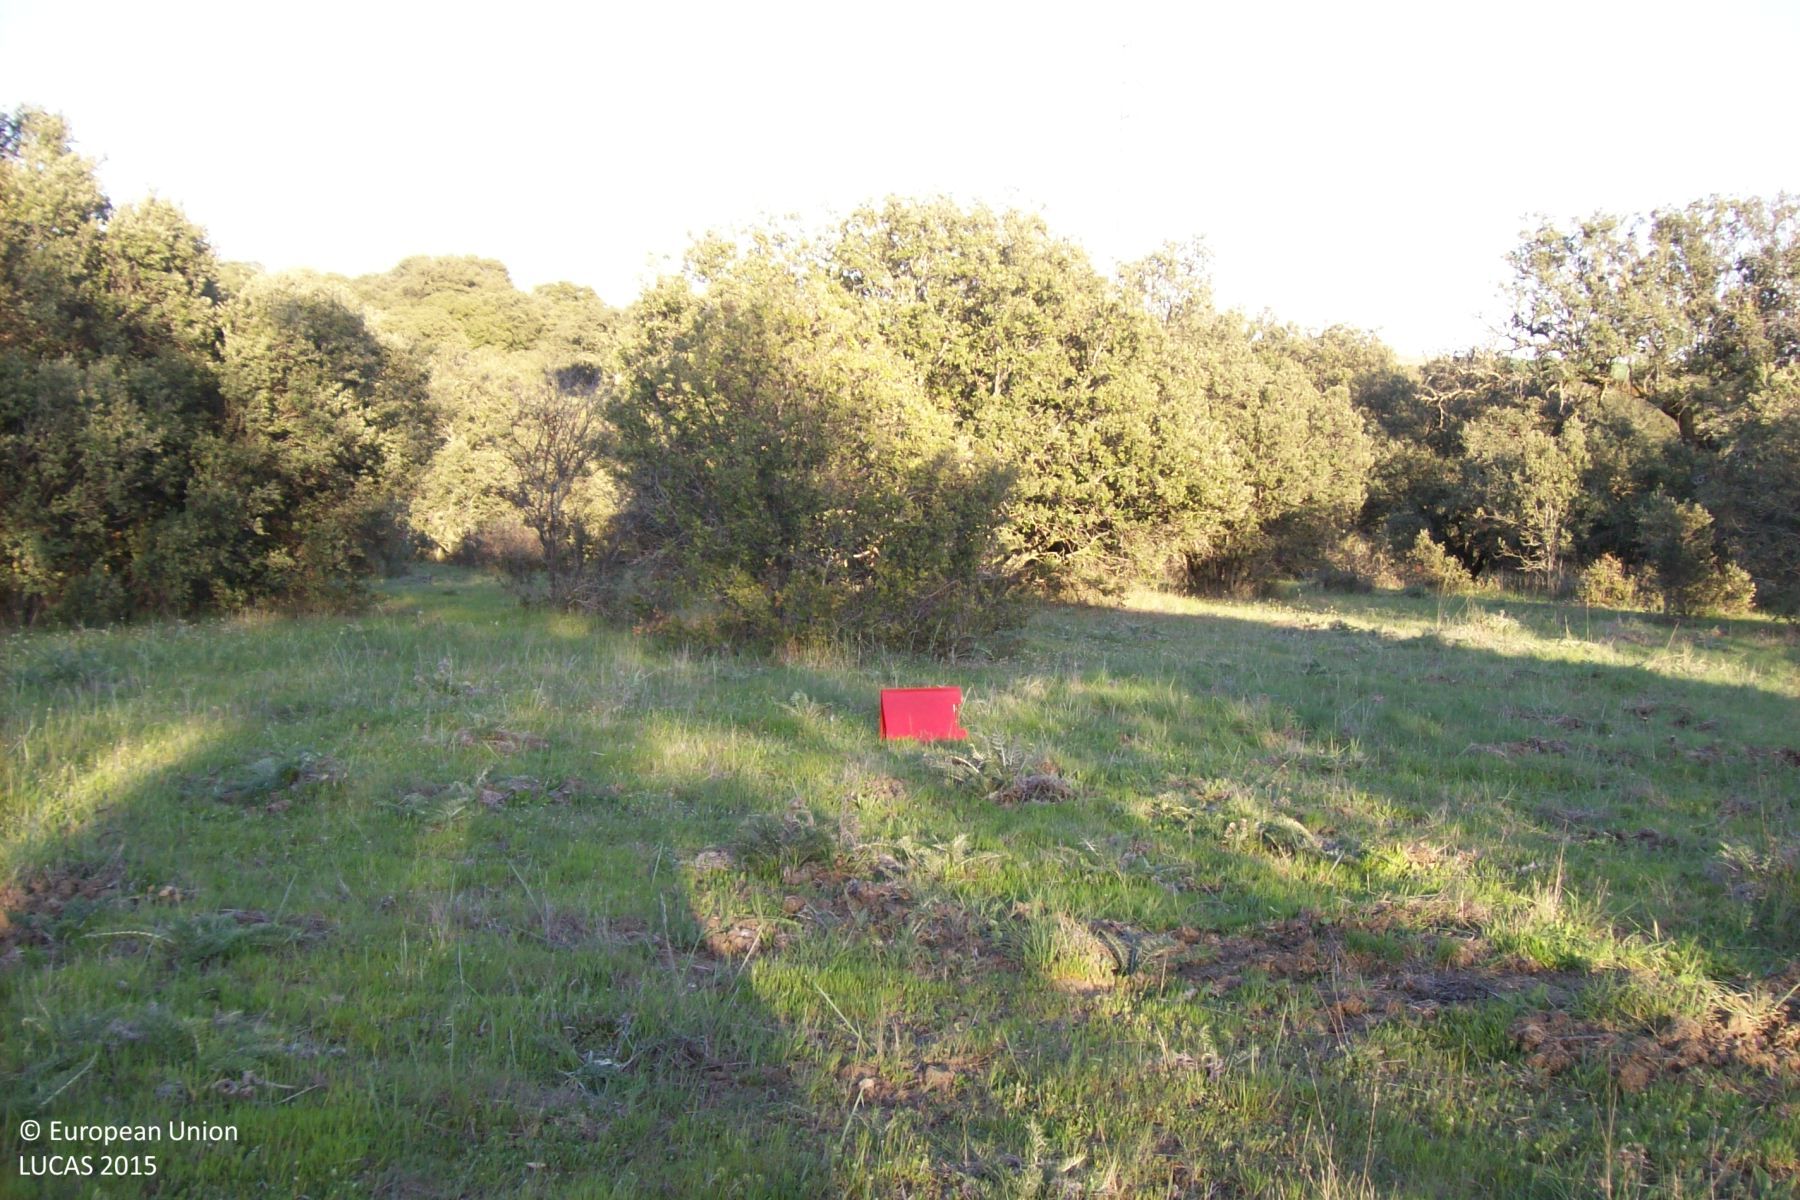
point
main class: Woodland
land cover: Broadleaved woodland
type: broadleaved evergreen forest
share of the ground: 25 - 50 %
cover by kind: herbaceous plants 55 %, broadleaved forest trees 45 %
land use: Forestry
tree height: < 5 m
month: April
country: ES
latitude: 40.4218
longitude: -3.9366
